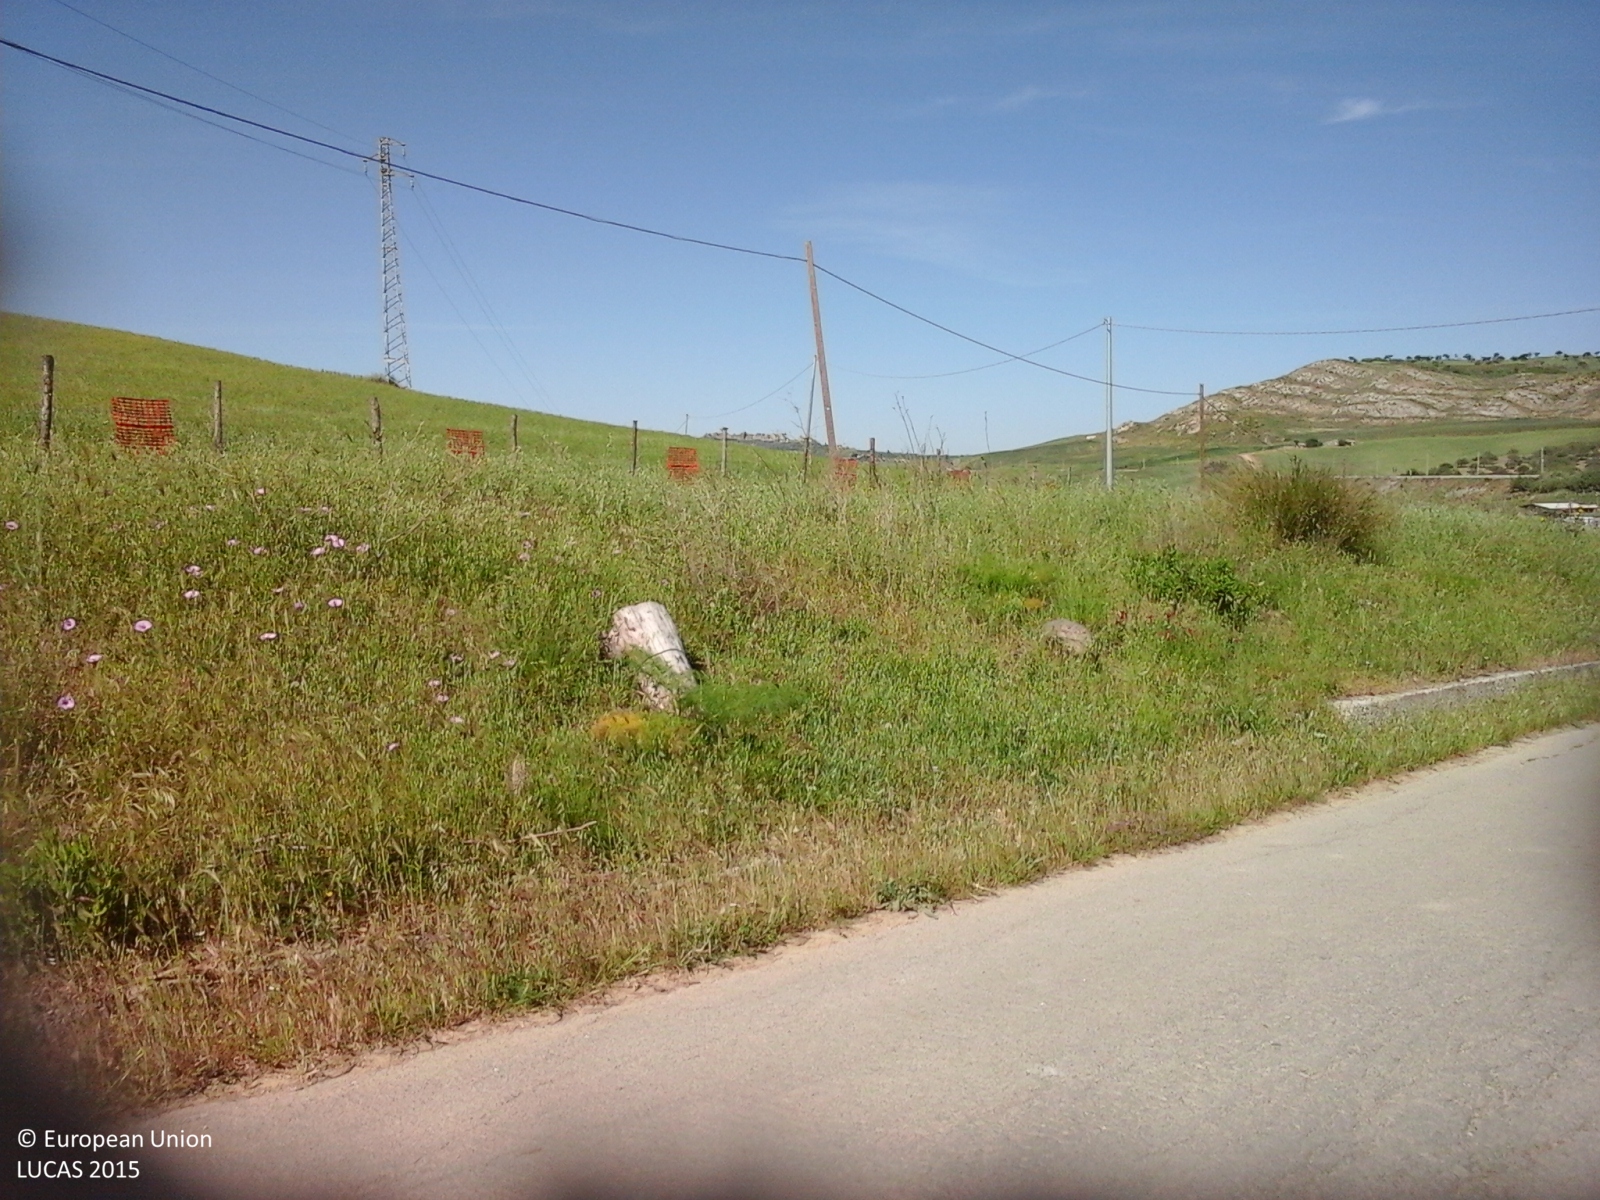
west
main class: Cropland
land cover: Olive groves
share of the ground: > 75 %
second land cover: Spontaneously vegetated surfaces
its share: > 75 %
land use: Agriculture (excluding fallow land and kitchen gardens)
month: May
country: IT
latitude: 37.4470
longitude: 13.9602
